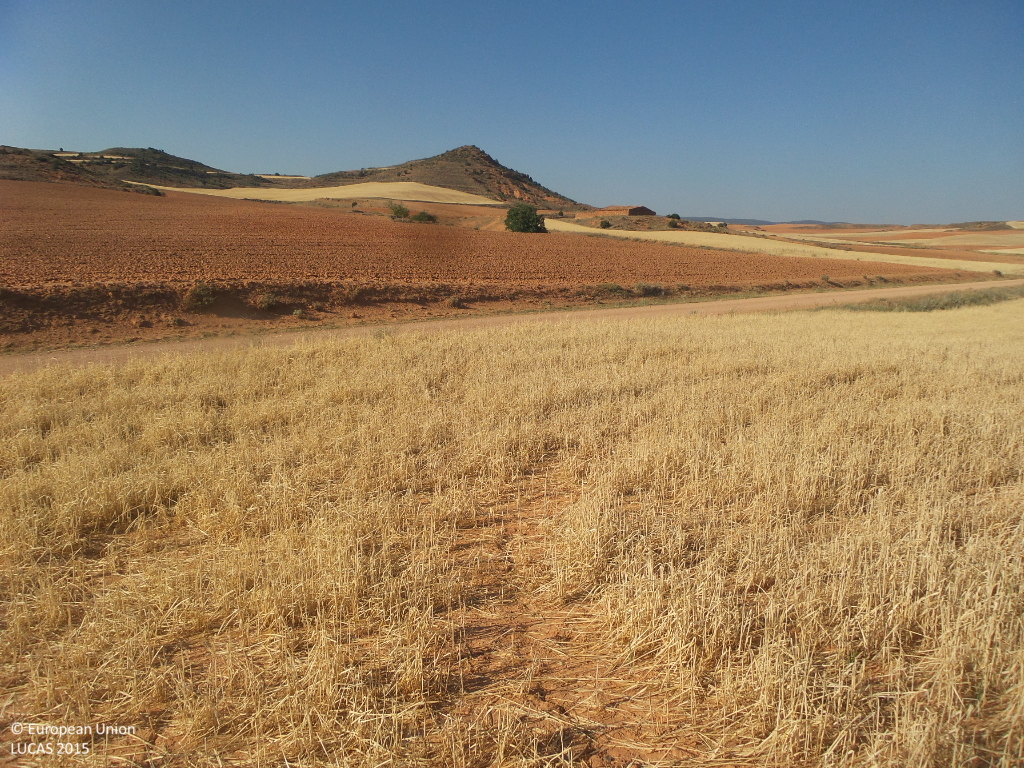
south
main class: Cropland
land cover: Barley
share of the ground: > 75 %
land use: Agriculture (excluding fallow land and kitchen gardens)
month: July
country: ES
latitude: 41.2157
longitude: -2.0868
